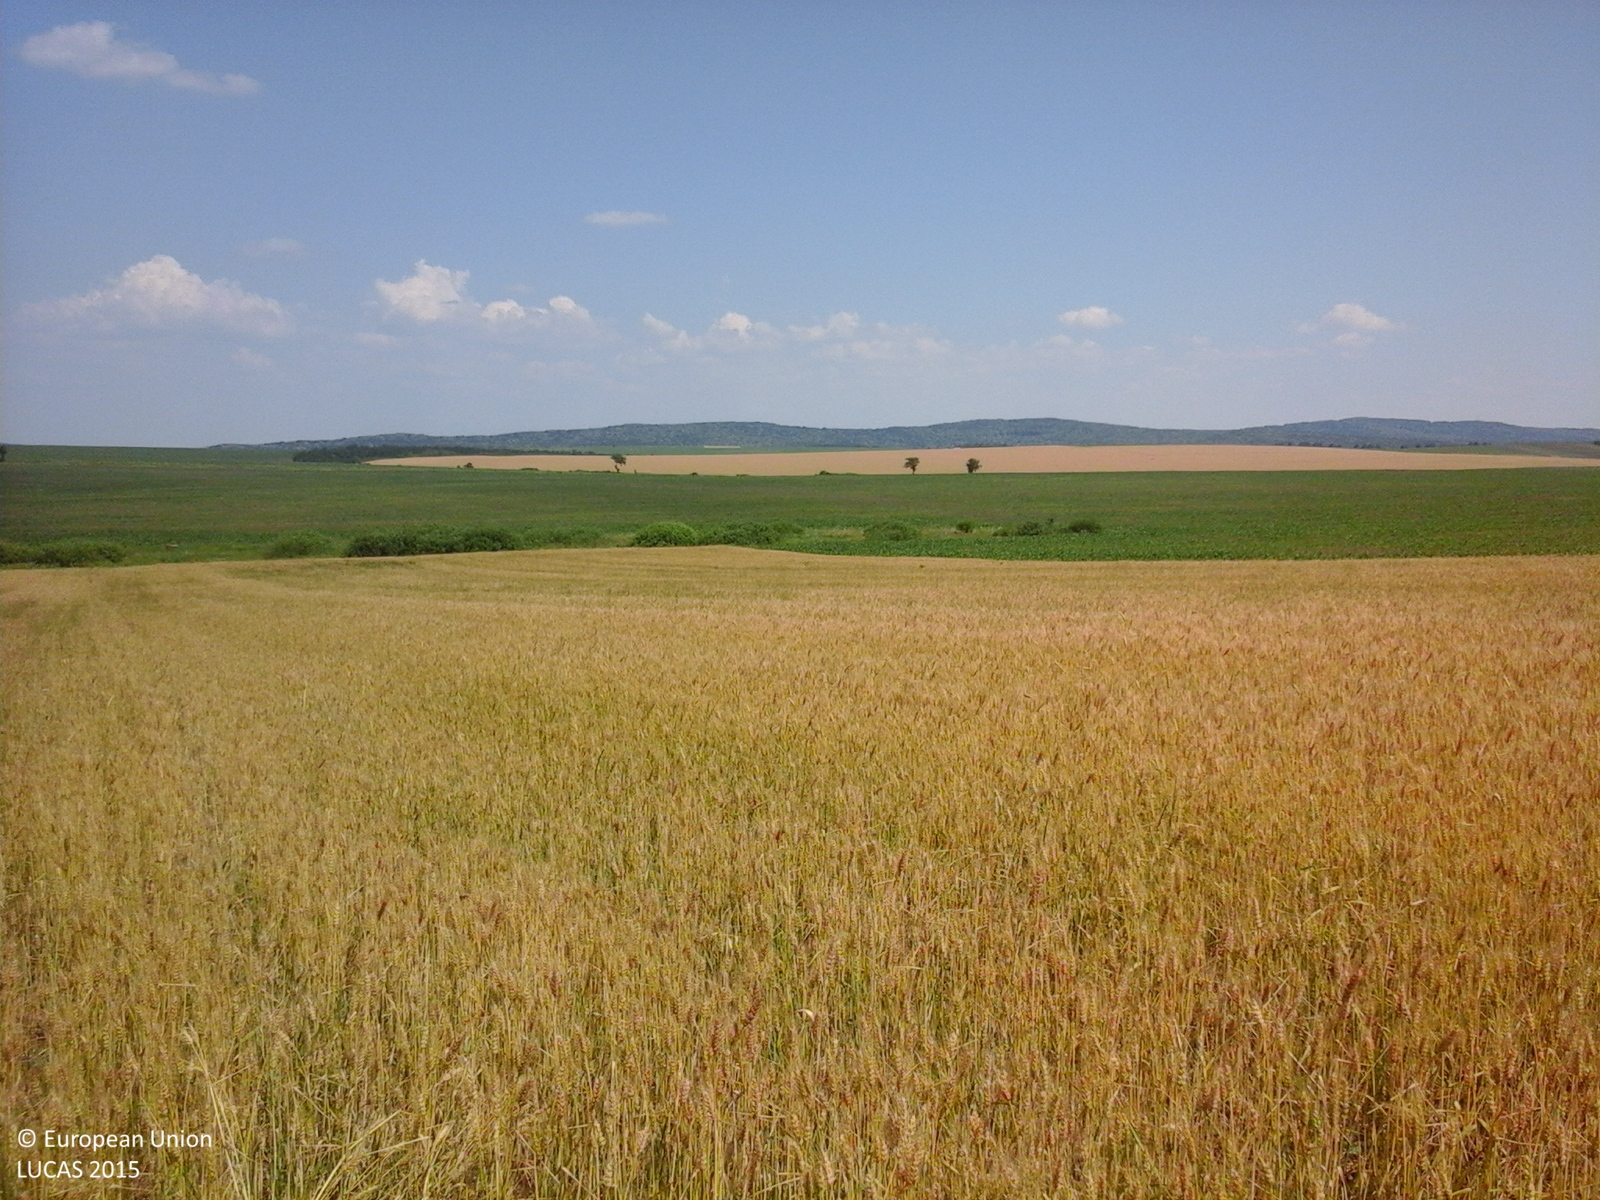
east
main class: Cropland
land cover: Common wheat
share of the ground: > 75 %
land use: Agriculture (excluding fallow land and kitchen gardens)
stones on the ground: 10 - 25 %
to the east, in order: Common wheat; Grass margins; Tracks; Inland marshes; Tracks; Grassland without tree/shrub cover; Maize
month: June
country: RO
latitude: 46.9965
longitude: 27.0247
